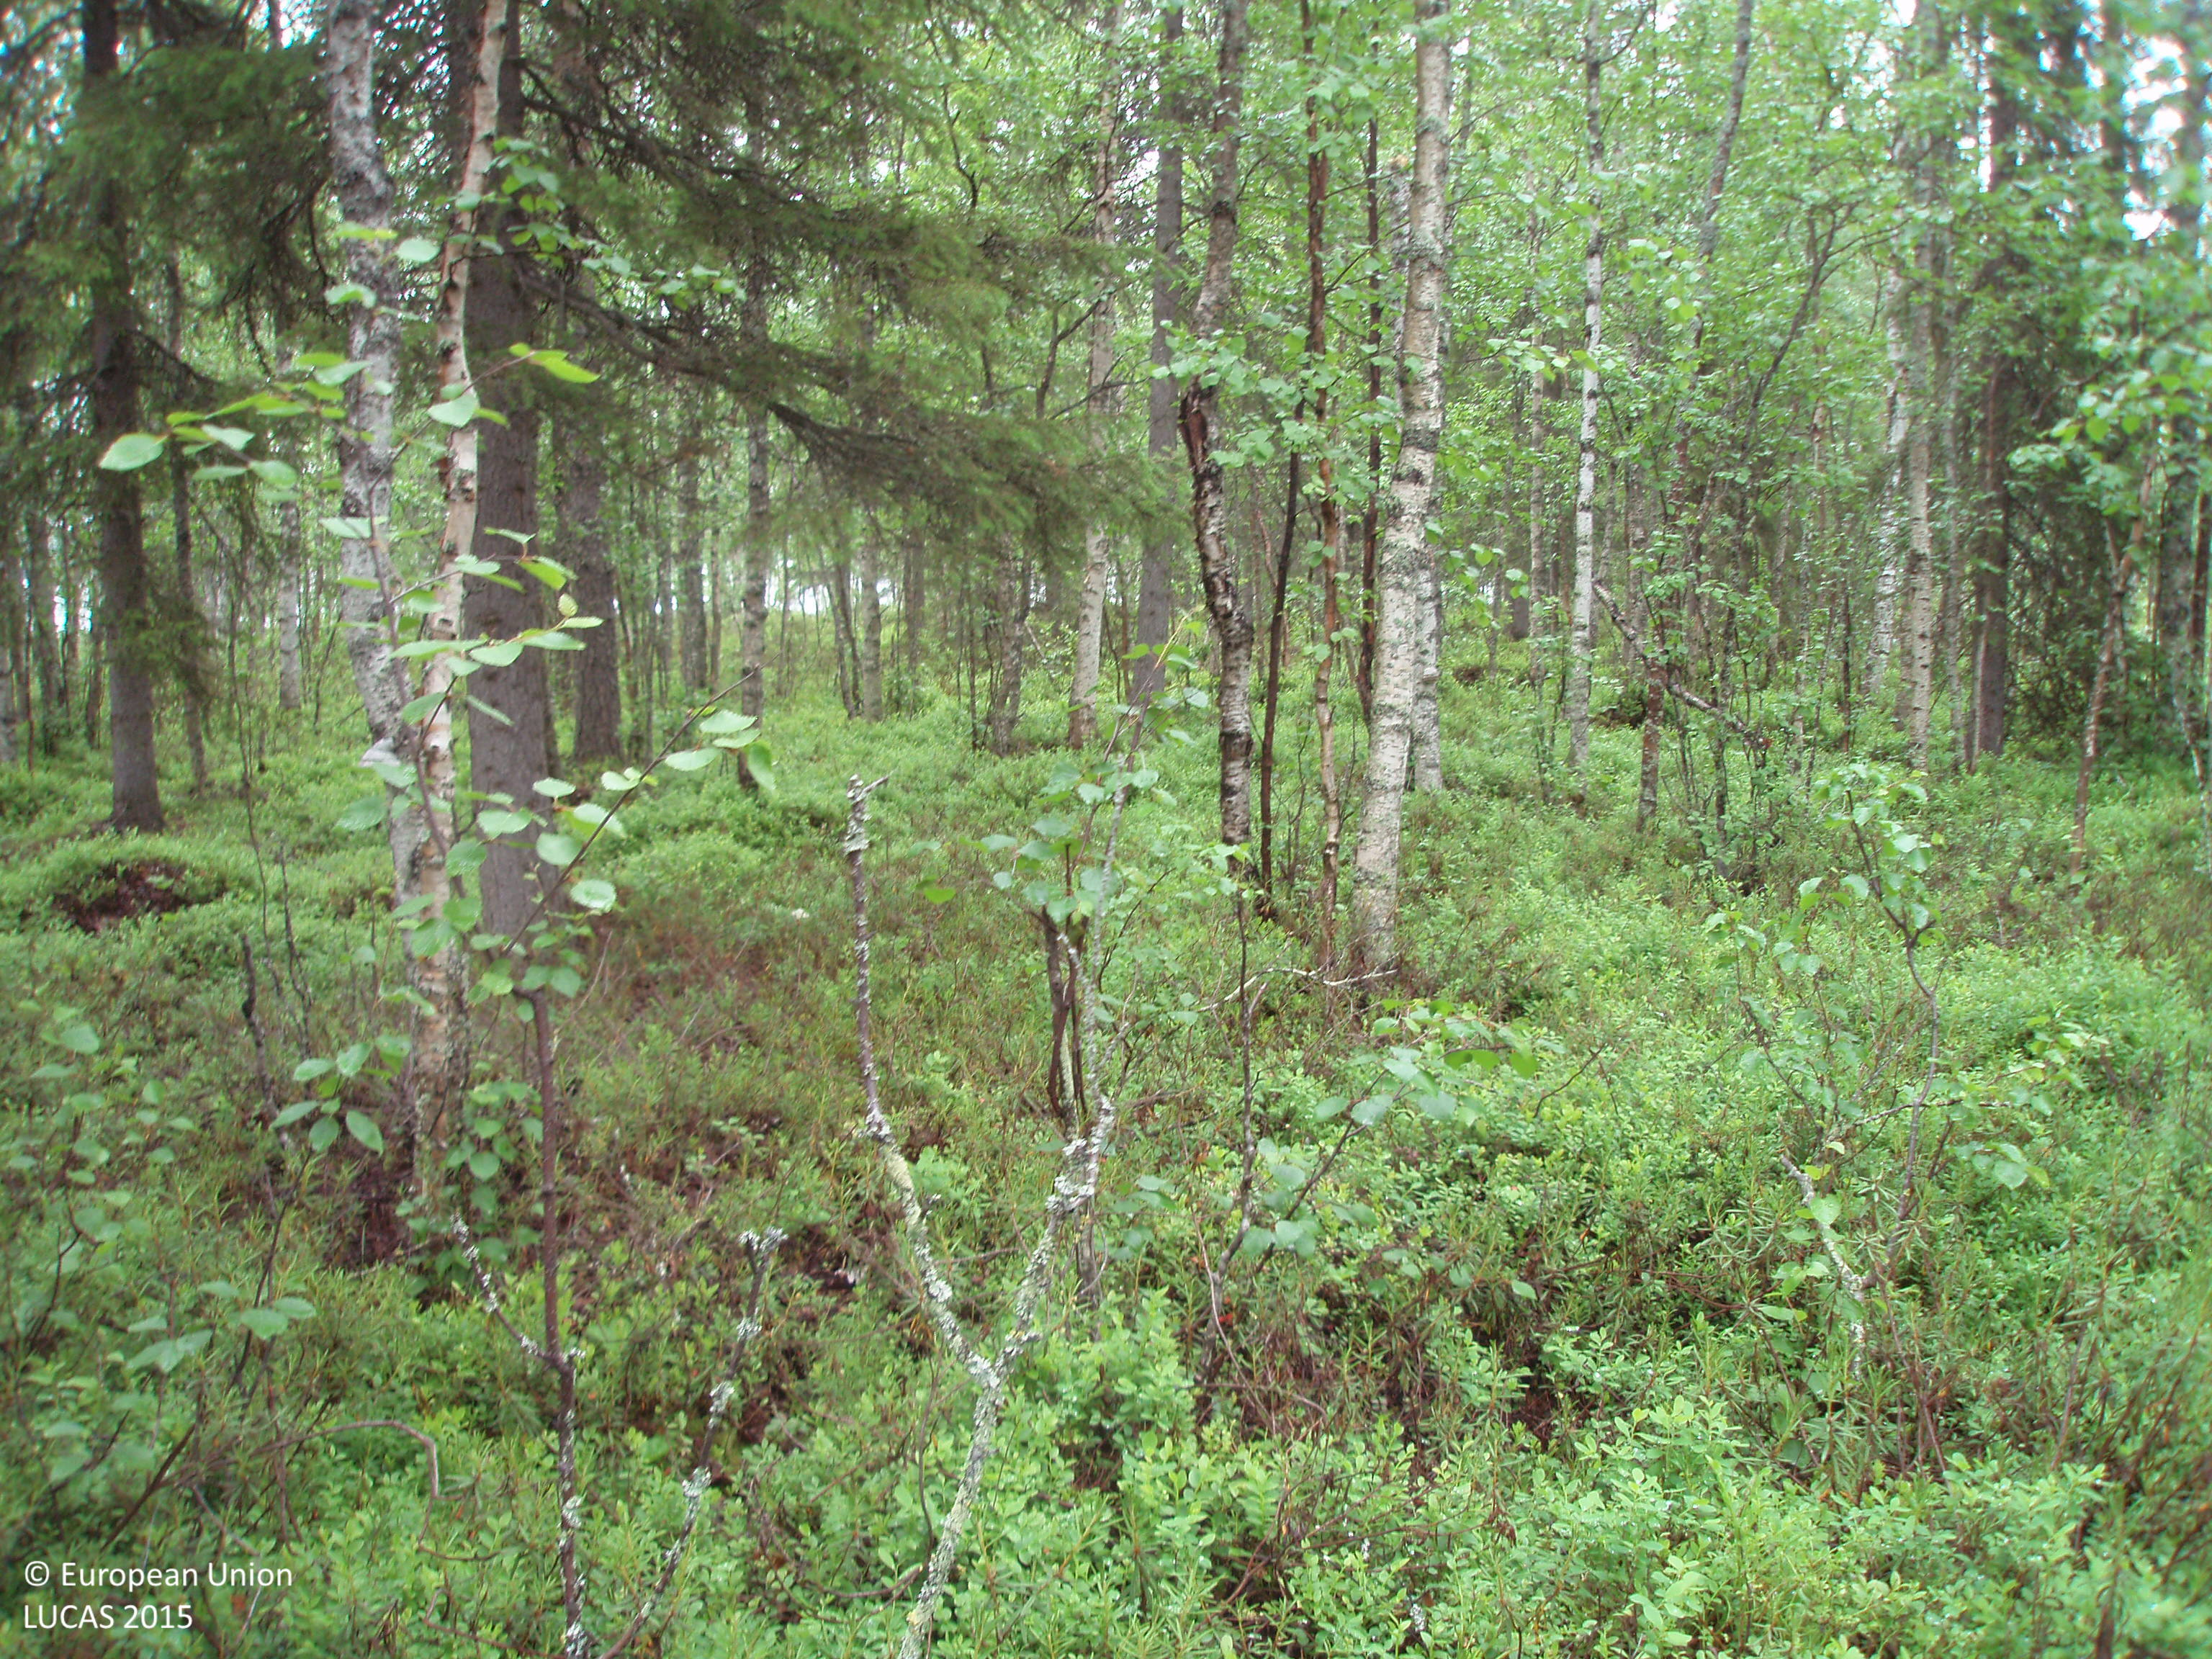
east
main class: Woodland
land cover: Spruce dominated mixed woodland
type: boreal forest
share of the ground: > 75 %
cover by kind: broadleaved forest trees 50 %, coniferous forest trees 35 %, shrubs 15 %
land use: Forestry
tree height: > 5 m
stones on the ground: < 10 %
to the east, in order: Spruce dominated mixed woodland; Ditches and canals; Spruce dominated mixed woodland; Ditches and canals; Spruce dominated mixed woodland; Ditches and canals; Spruce dominated mixed woodland; Fences; Spruce dominated mixed woodland; Ditches and canals; Spruce dominated mixed woodland; Ditches and canals; Spruce dominated mixed woodland; Ditches and canals; Spruce dominated mixed woodland
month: July
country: FI
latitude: 67.4645
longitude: 27.0852
